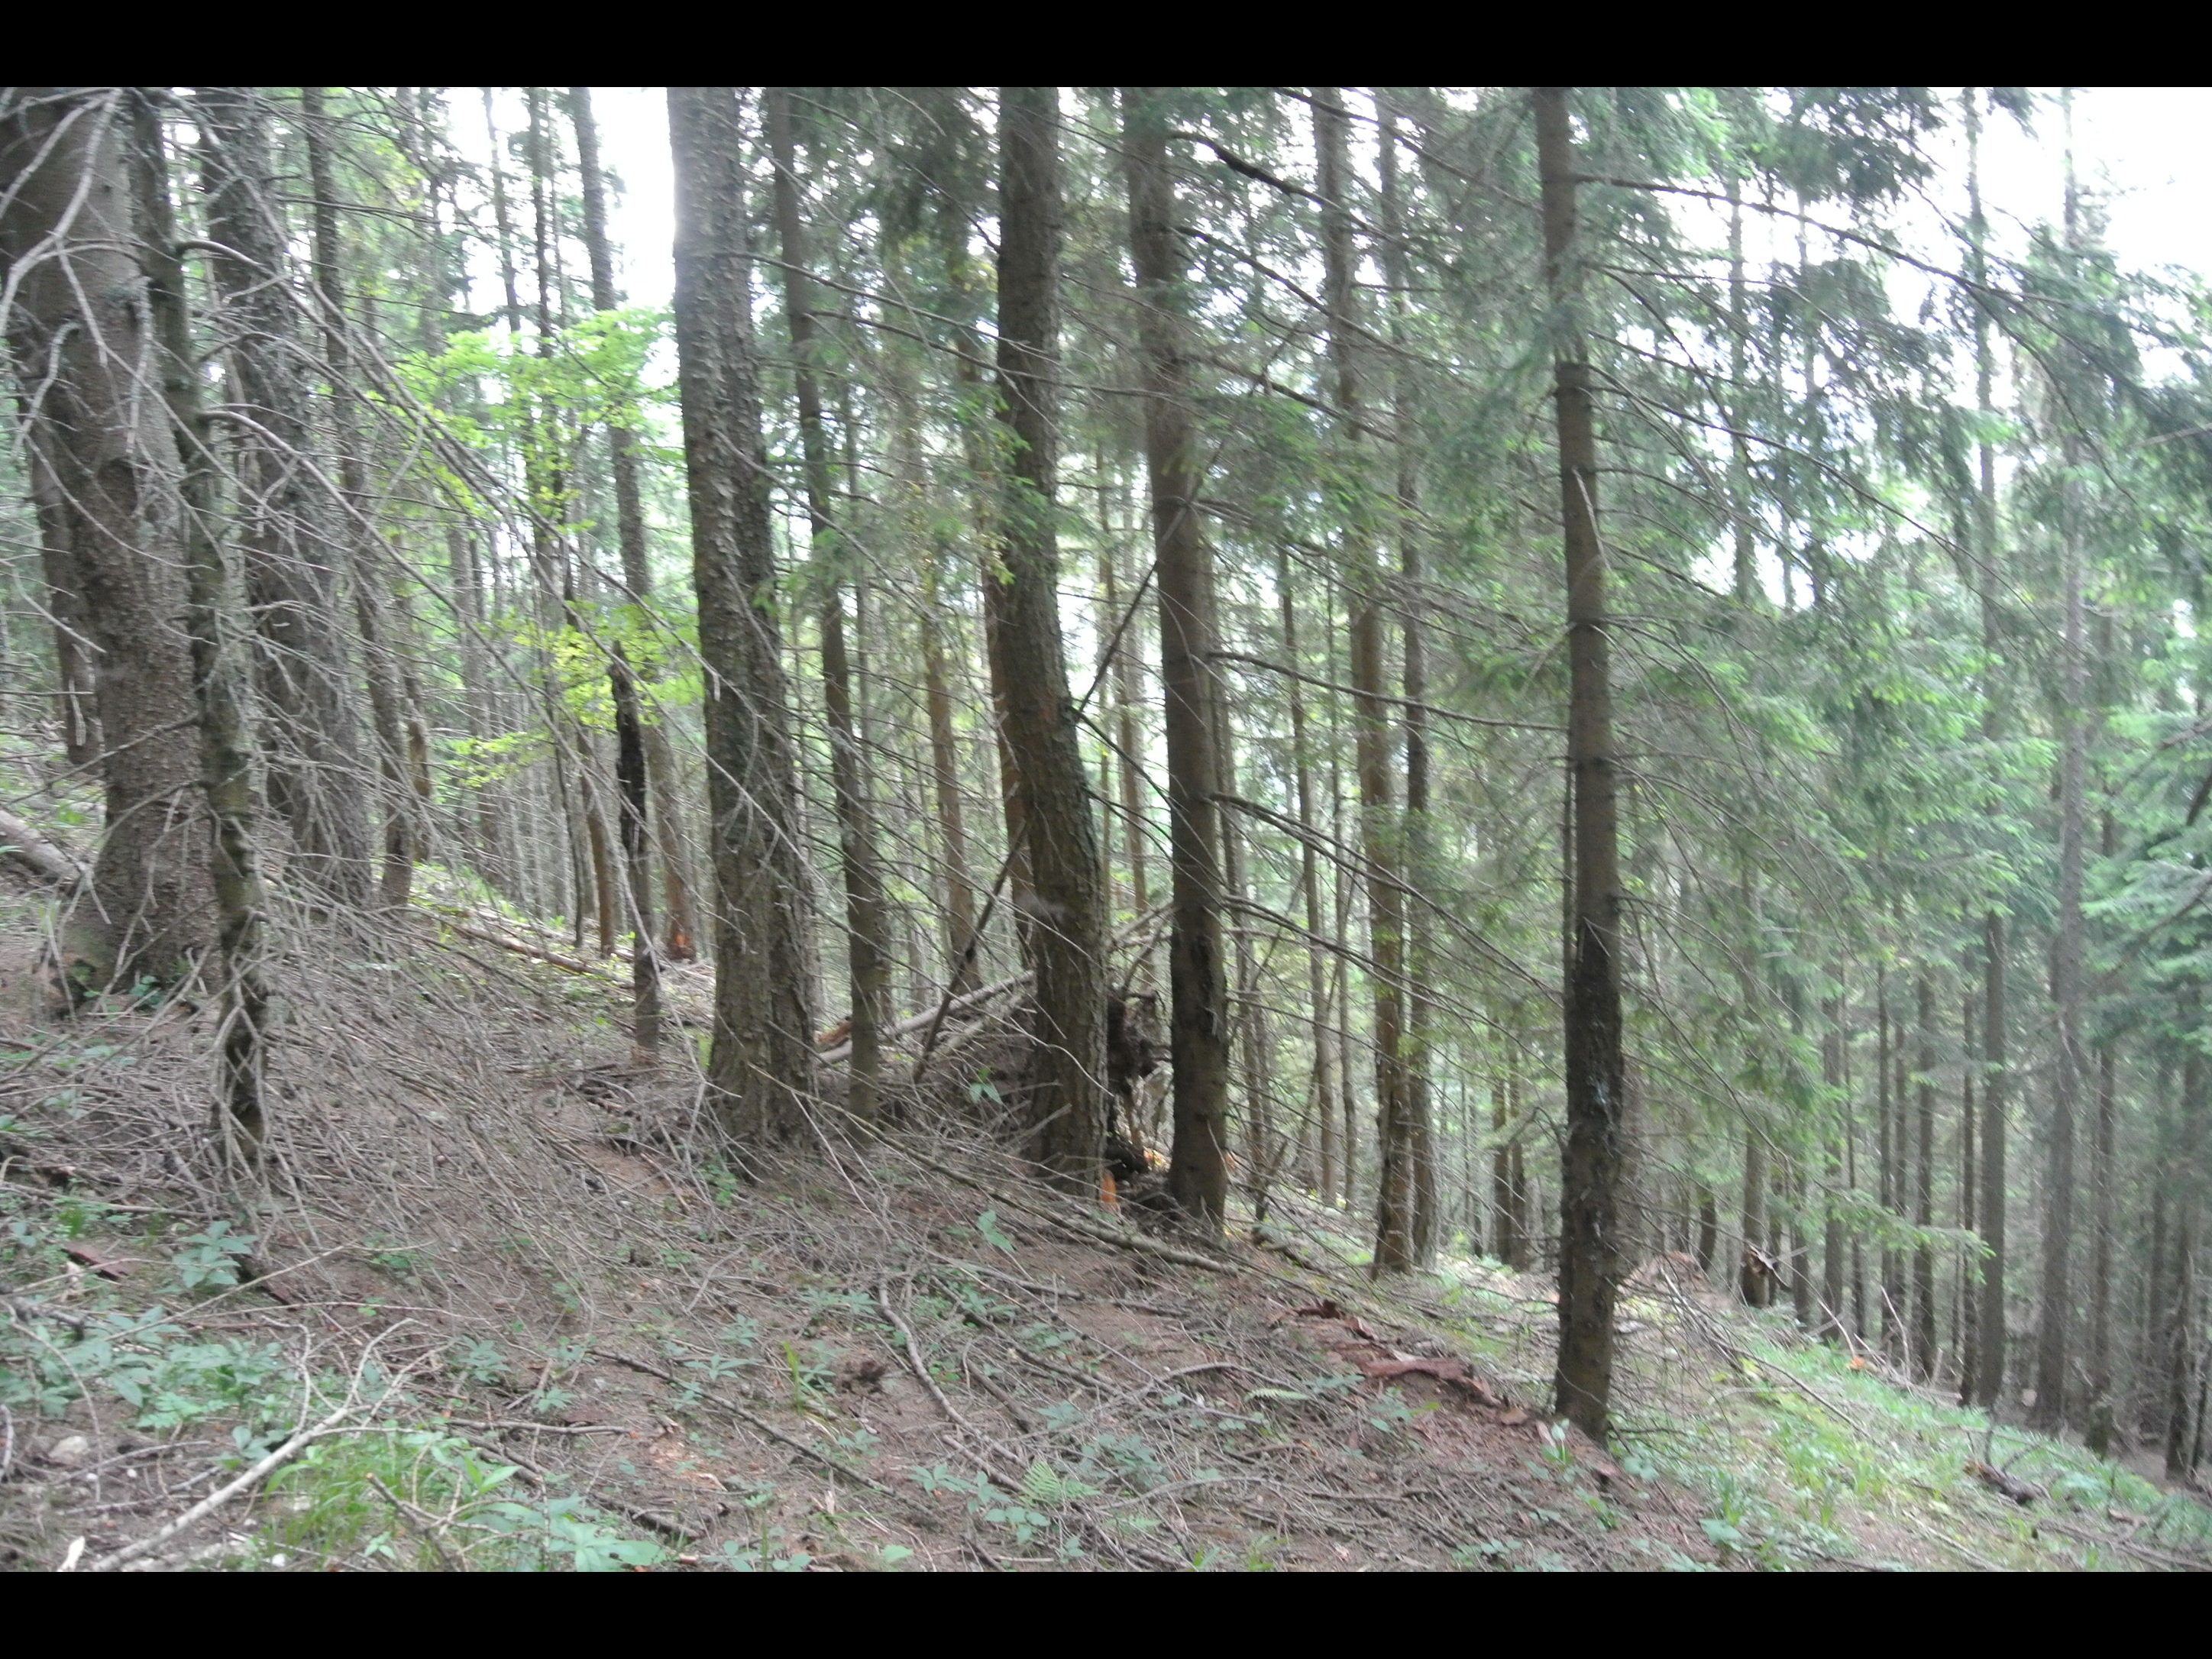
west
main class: Woodland
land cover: Spruce dominated coniferous woodland
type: alpine coniferous forest
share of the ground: > 75 %
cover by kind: coniferous forest trees 95 %, herbaceous plants 5 %
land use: Forestry
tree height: > 5 m
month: June
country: AT
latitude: 47.8190
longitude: 15.7855
